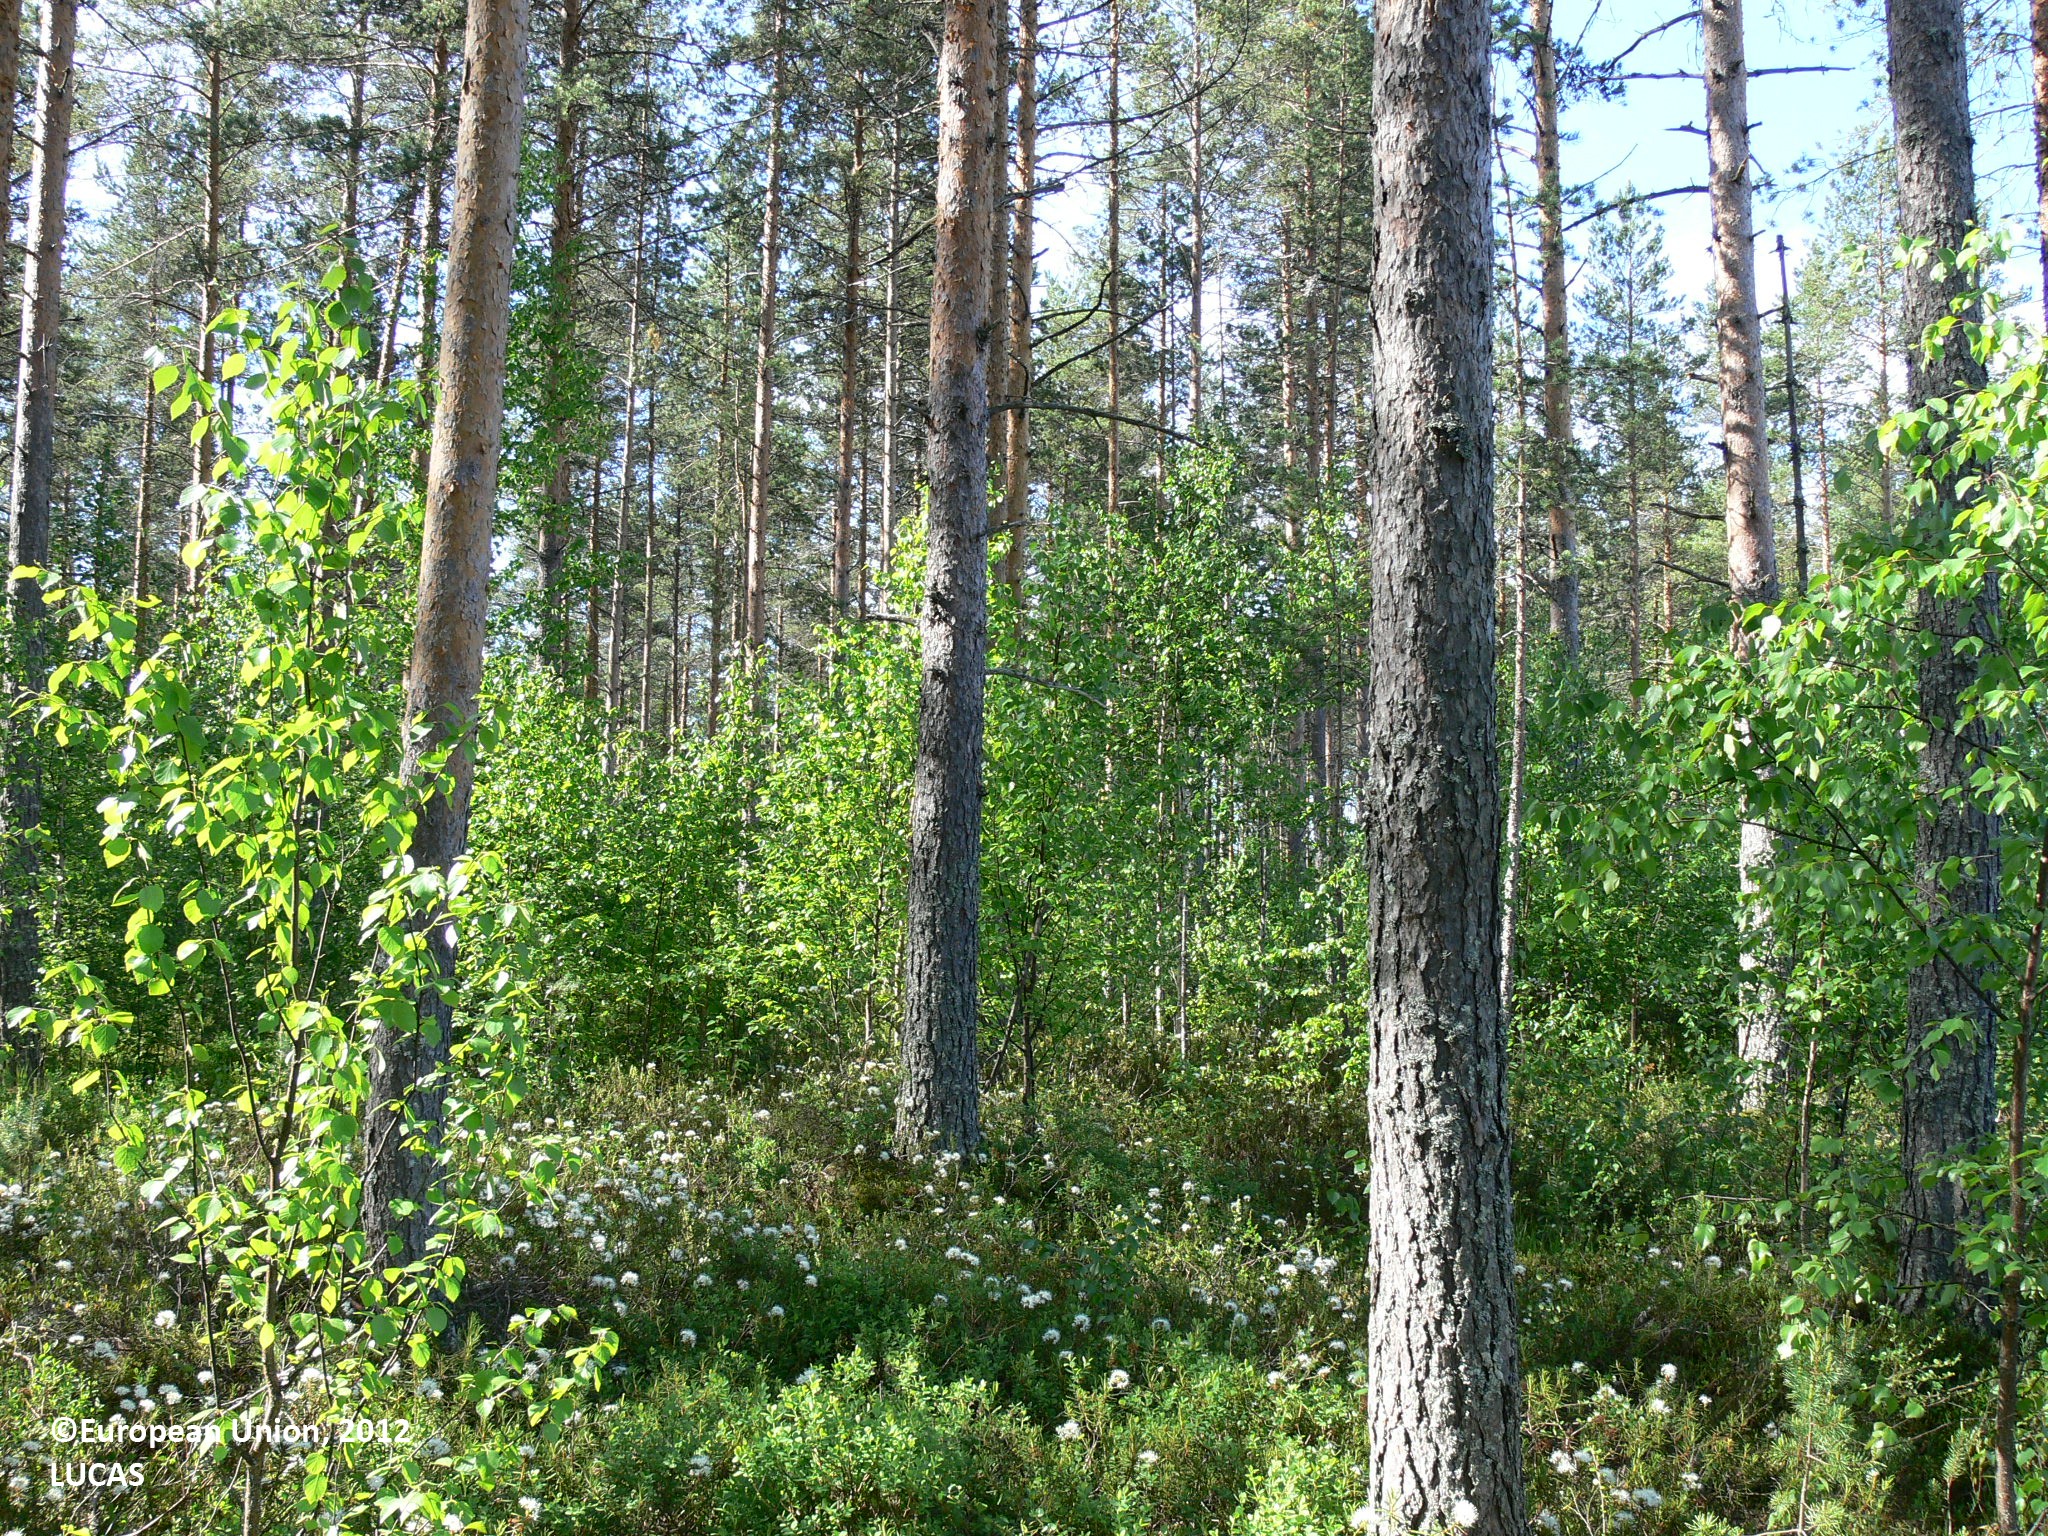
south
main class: Woodland
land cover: Pine dominated coniferous woodland
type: boreal forest
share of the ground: > 75 %
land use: Forestry
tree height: > 5 m
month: June
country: FI
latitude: 62.6683
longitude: 29.8732
